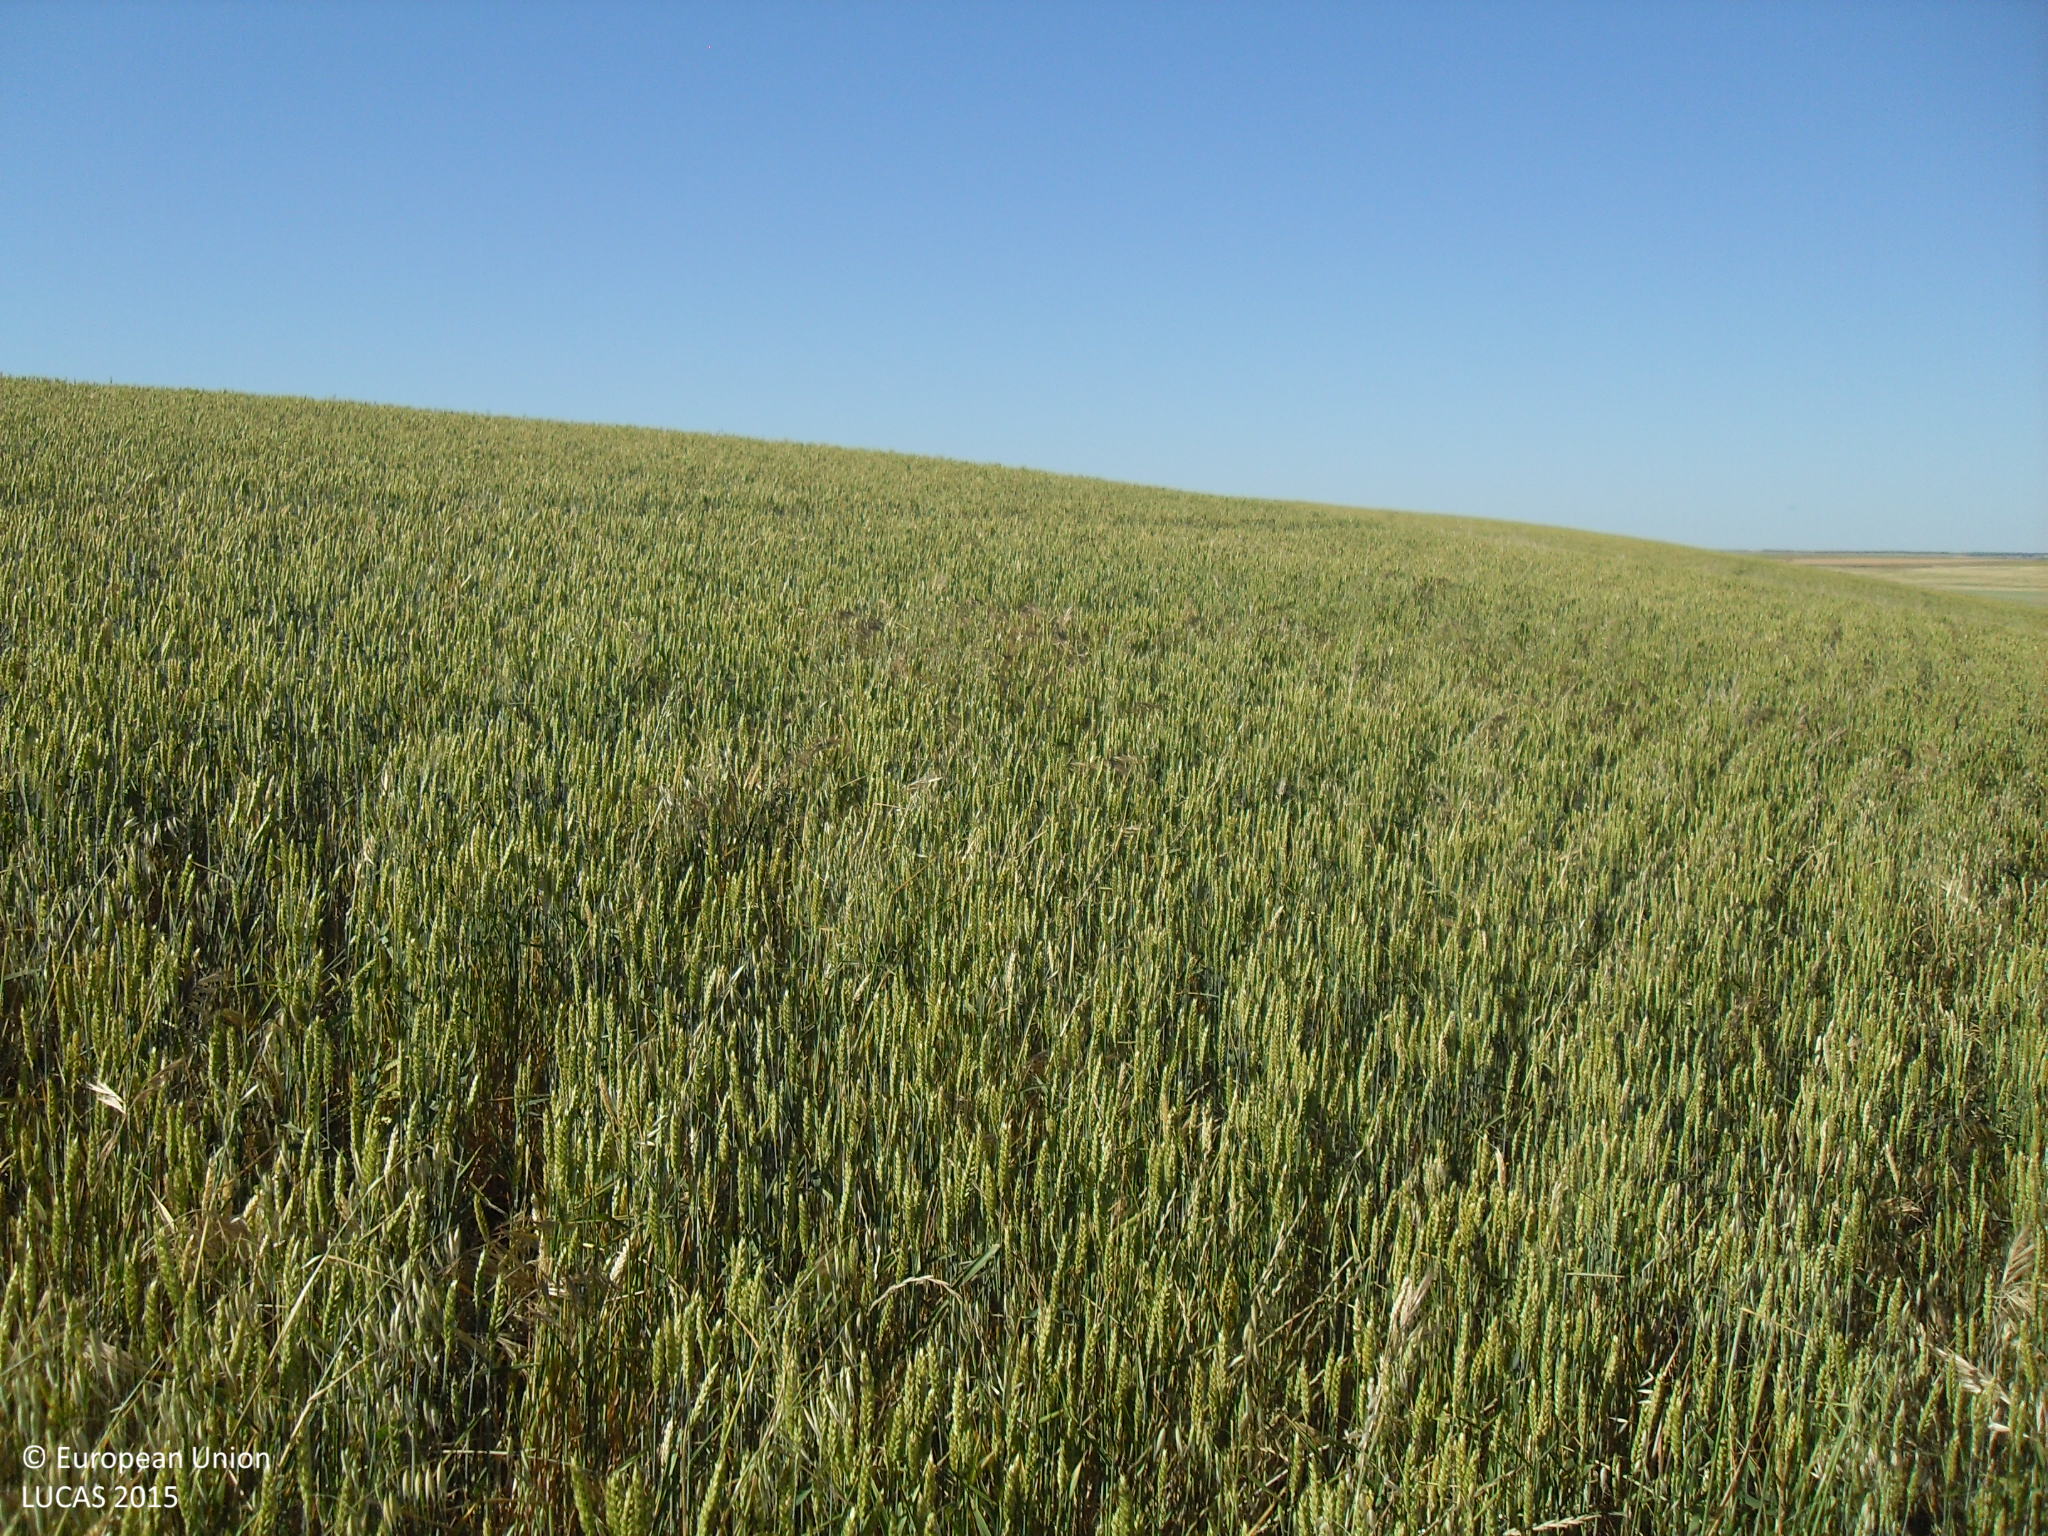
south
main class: Cropland
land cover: Common wheat
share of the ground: > 75 %
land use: Agriculture (excluding fallow land and kitchen gardens)
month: May
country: ES
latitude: 41.1657
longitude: -5.2199
